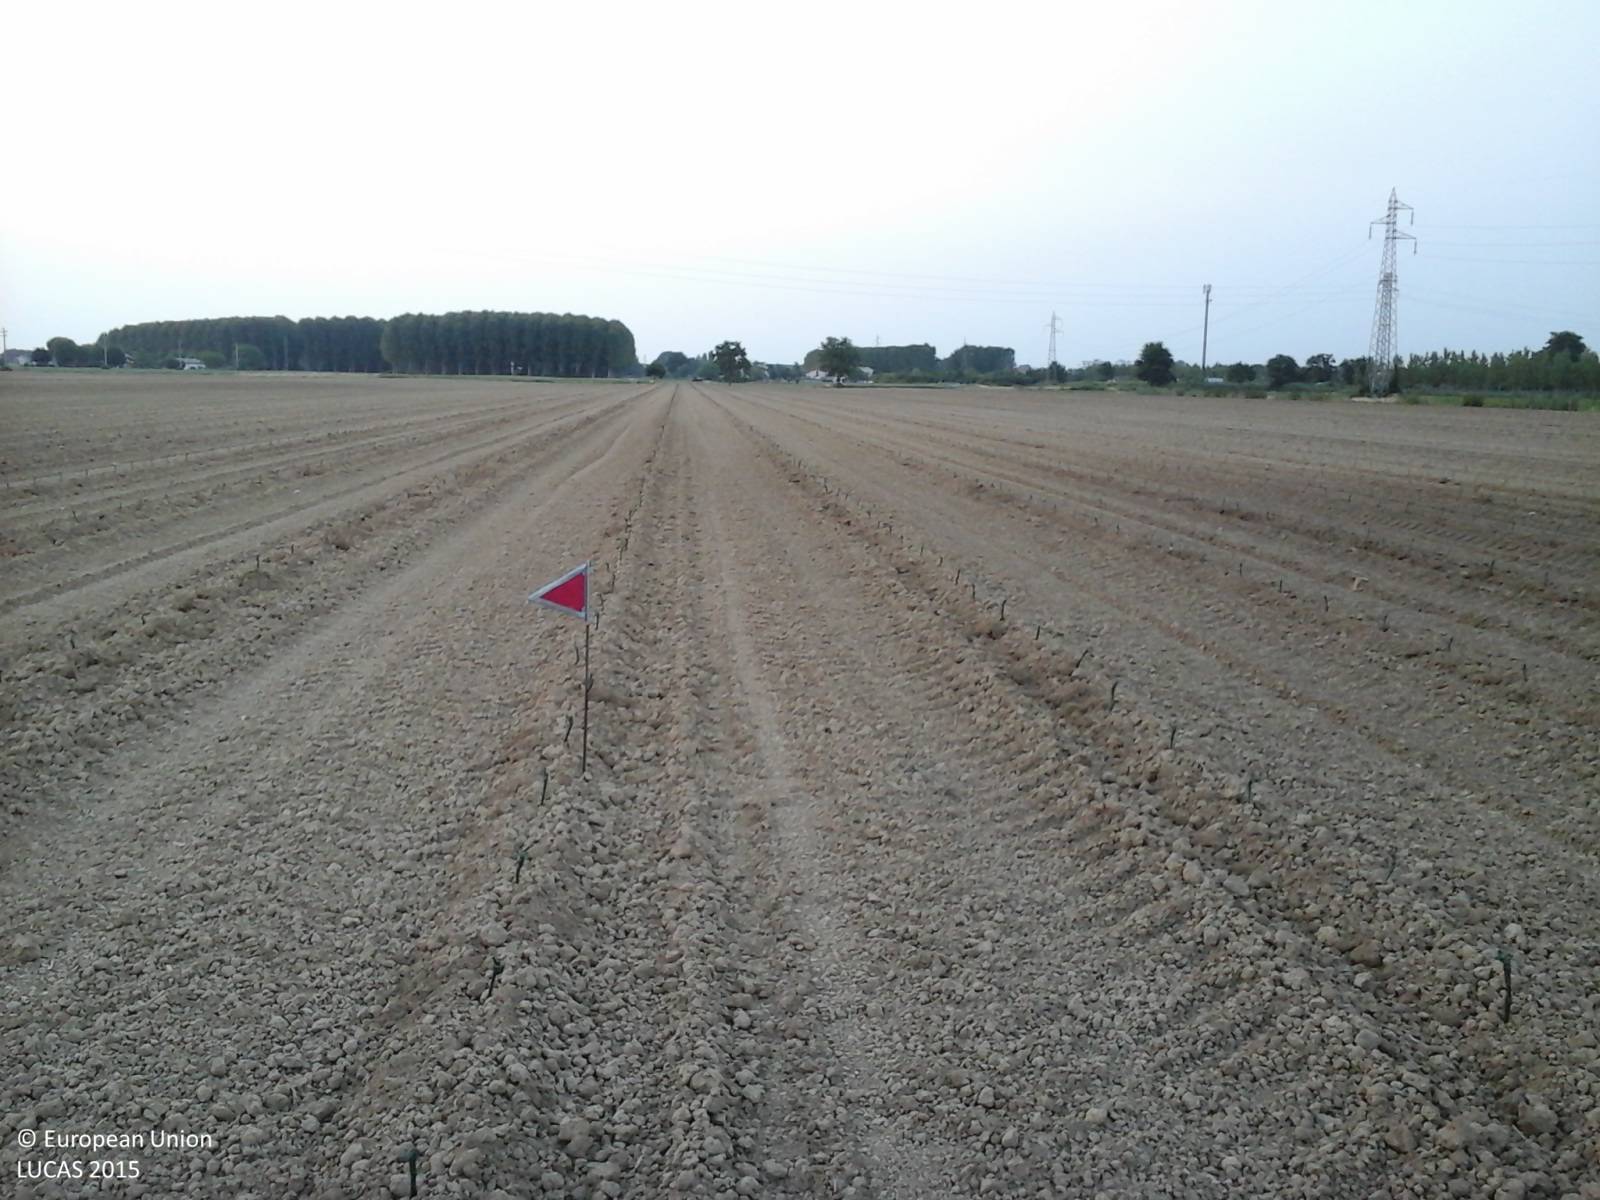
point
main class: Cropland
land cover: Vineyards
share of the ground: < 10 %
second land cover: Other bare soil
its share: > 75 %
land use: Agriculture (excluding fallow land and kitchen gardens)
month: June
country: IT
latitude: 45.8166
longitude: 13.2007
